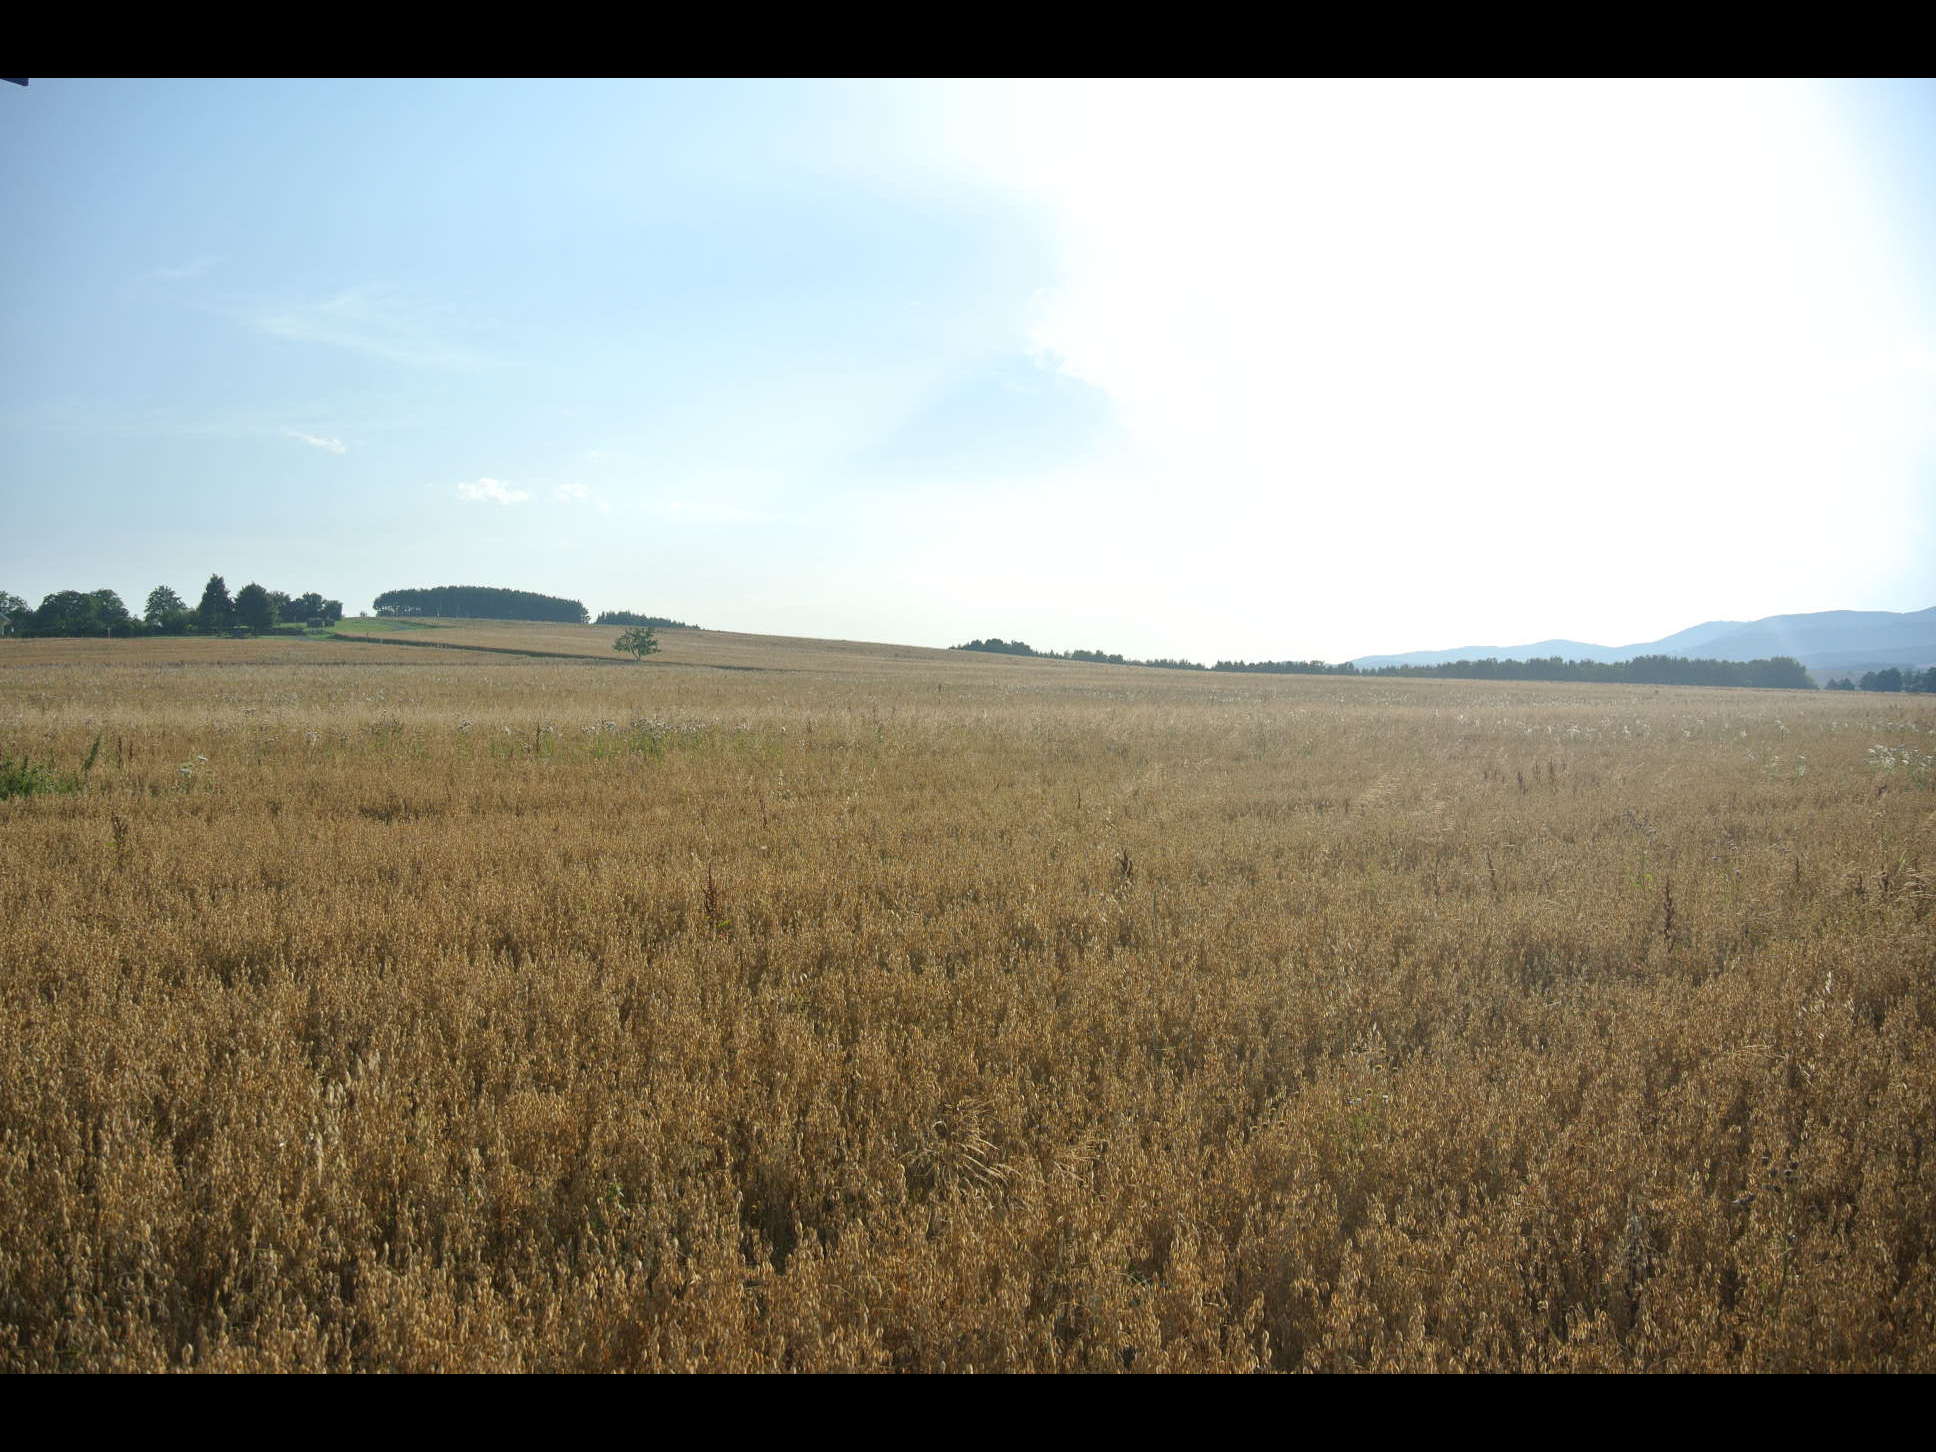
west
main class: Cropland
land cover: Oats
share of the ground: > 75 %
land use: Agriculture (excluding fallow land and kitchen gardens)
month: July
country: AT
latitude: 47.4070
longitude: 16.3773
